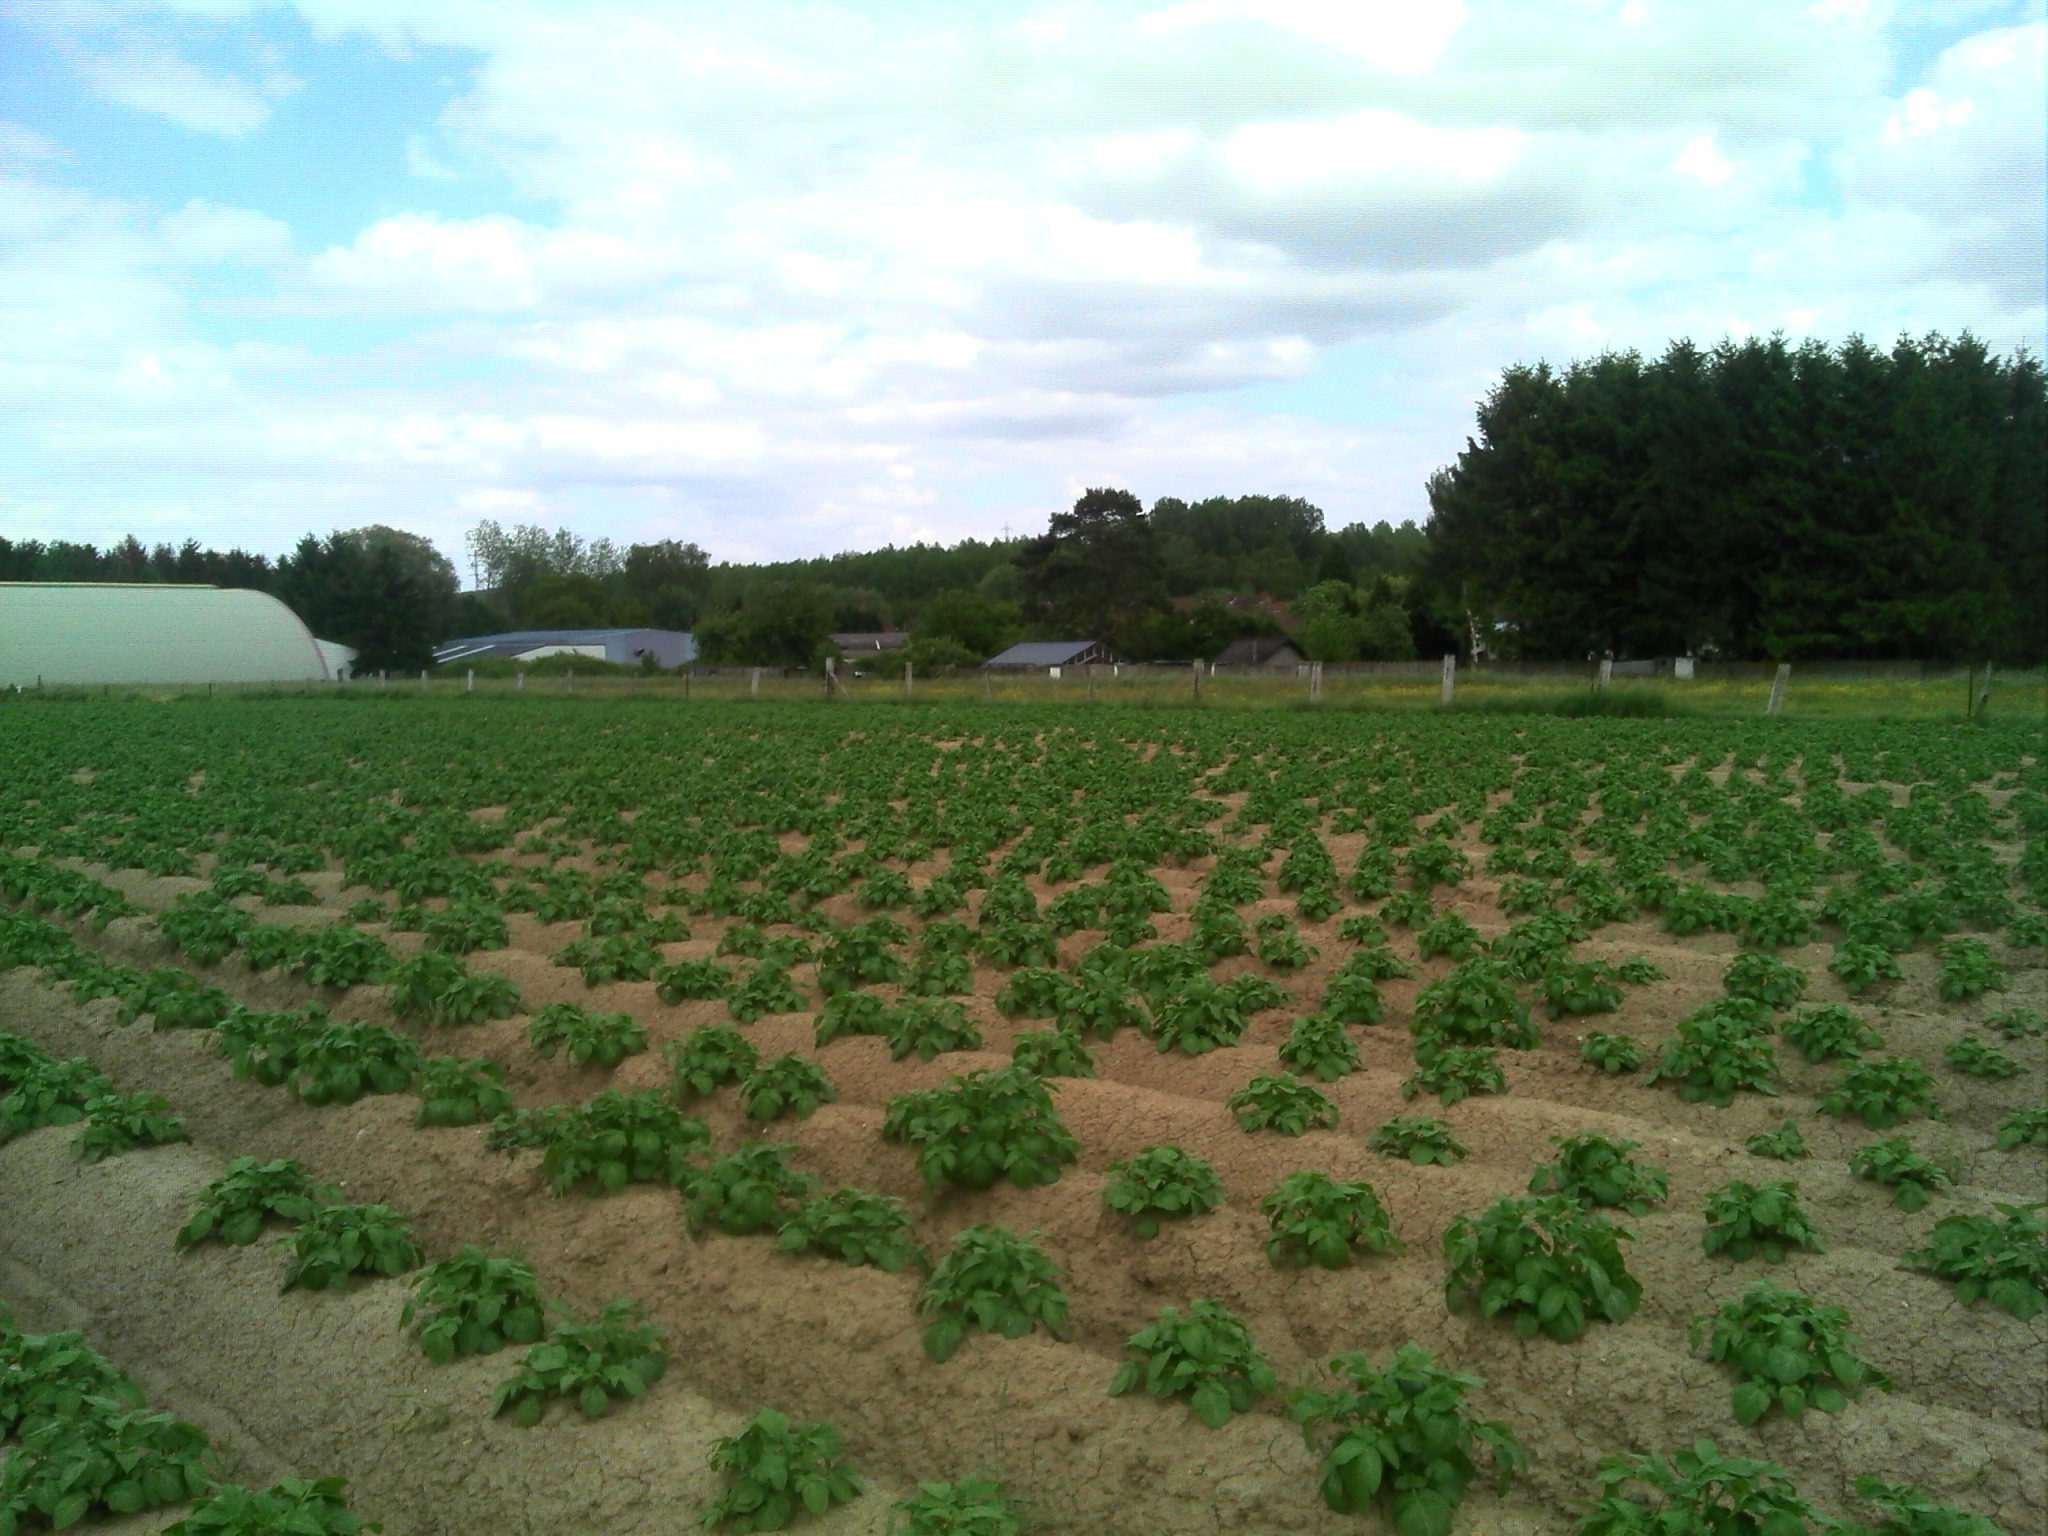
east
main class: Cropland
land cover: Potatoes
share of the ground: 10 - 25 %
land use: Agriculture (excluding fallow land and kitchen gardens)
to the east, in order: Potatoes; Fences; Grassland without tree/shrub cover; Fences; Grass margins; Artificial constructions in urban areas
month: June
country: BE
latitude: 50.4555
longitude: 4.6581
